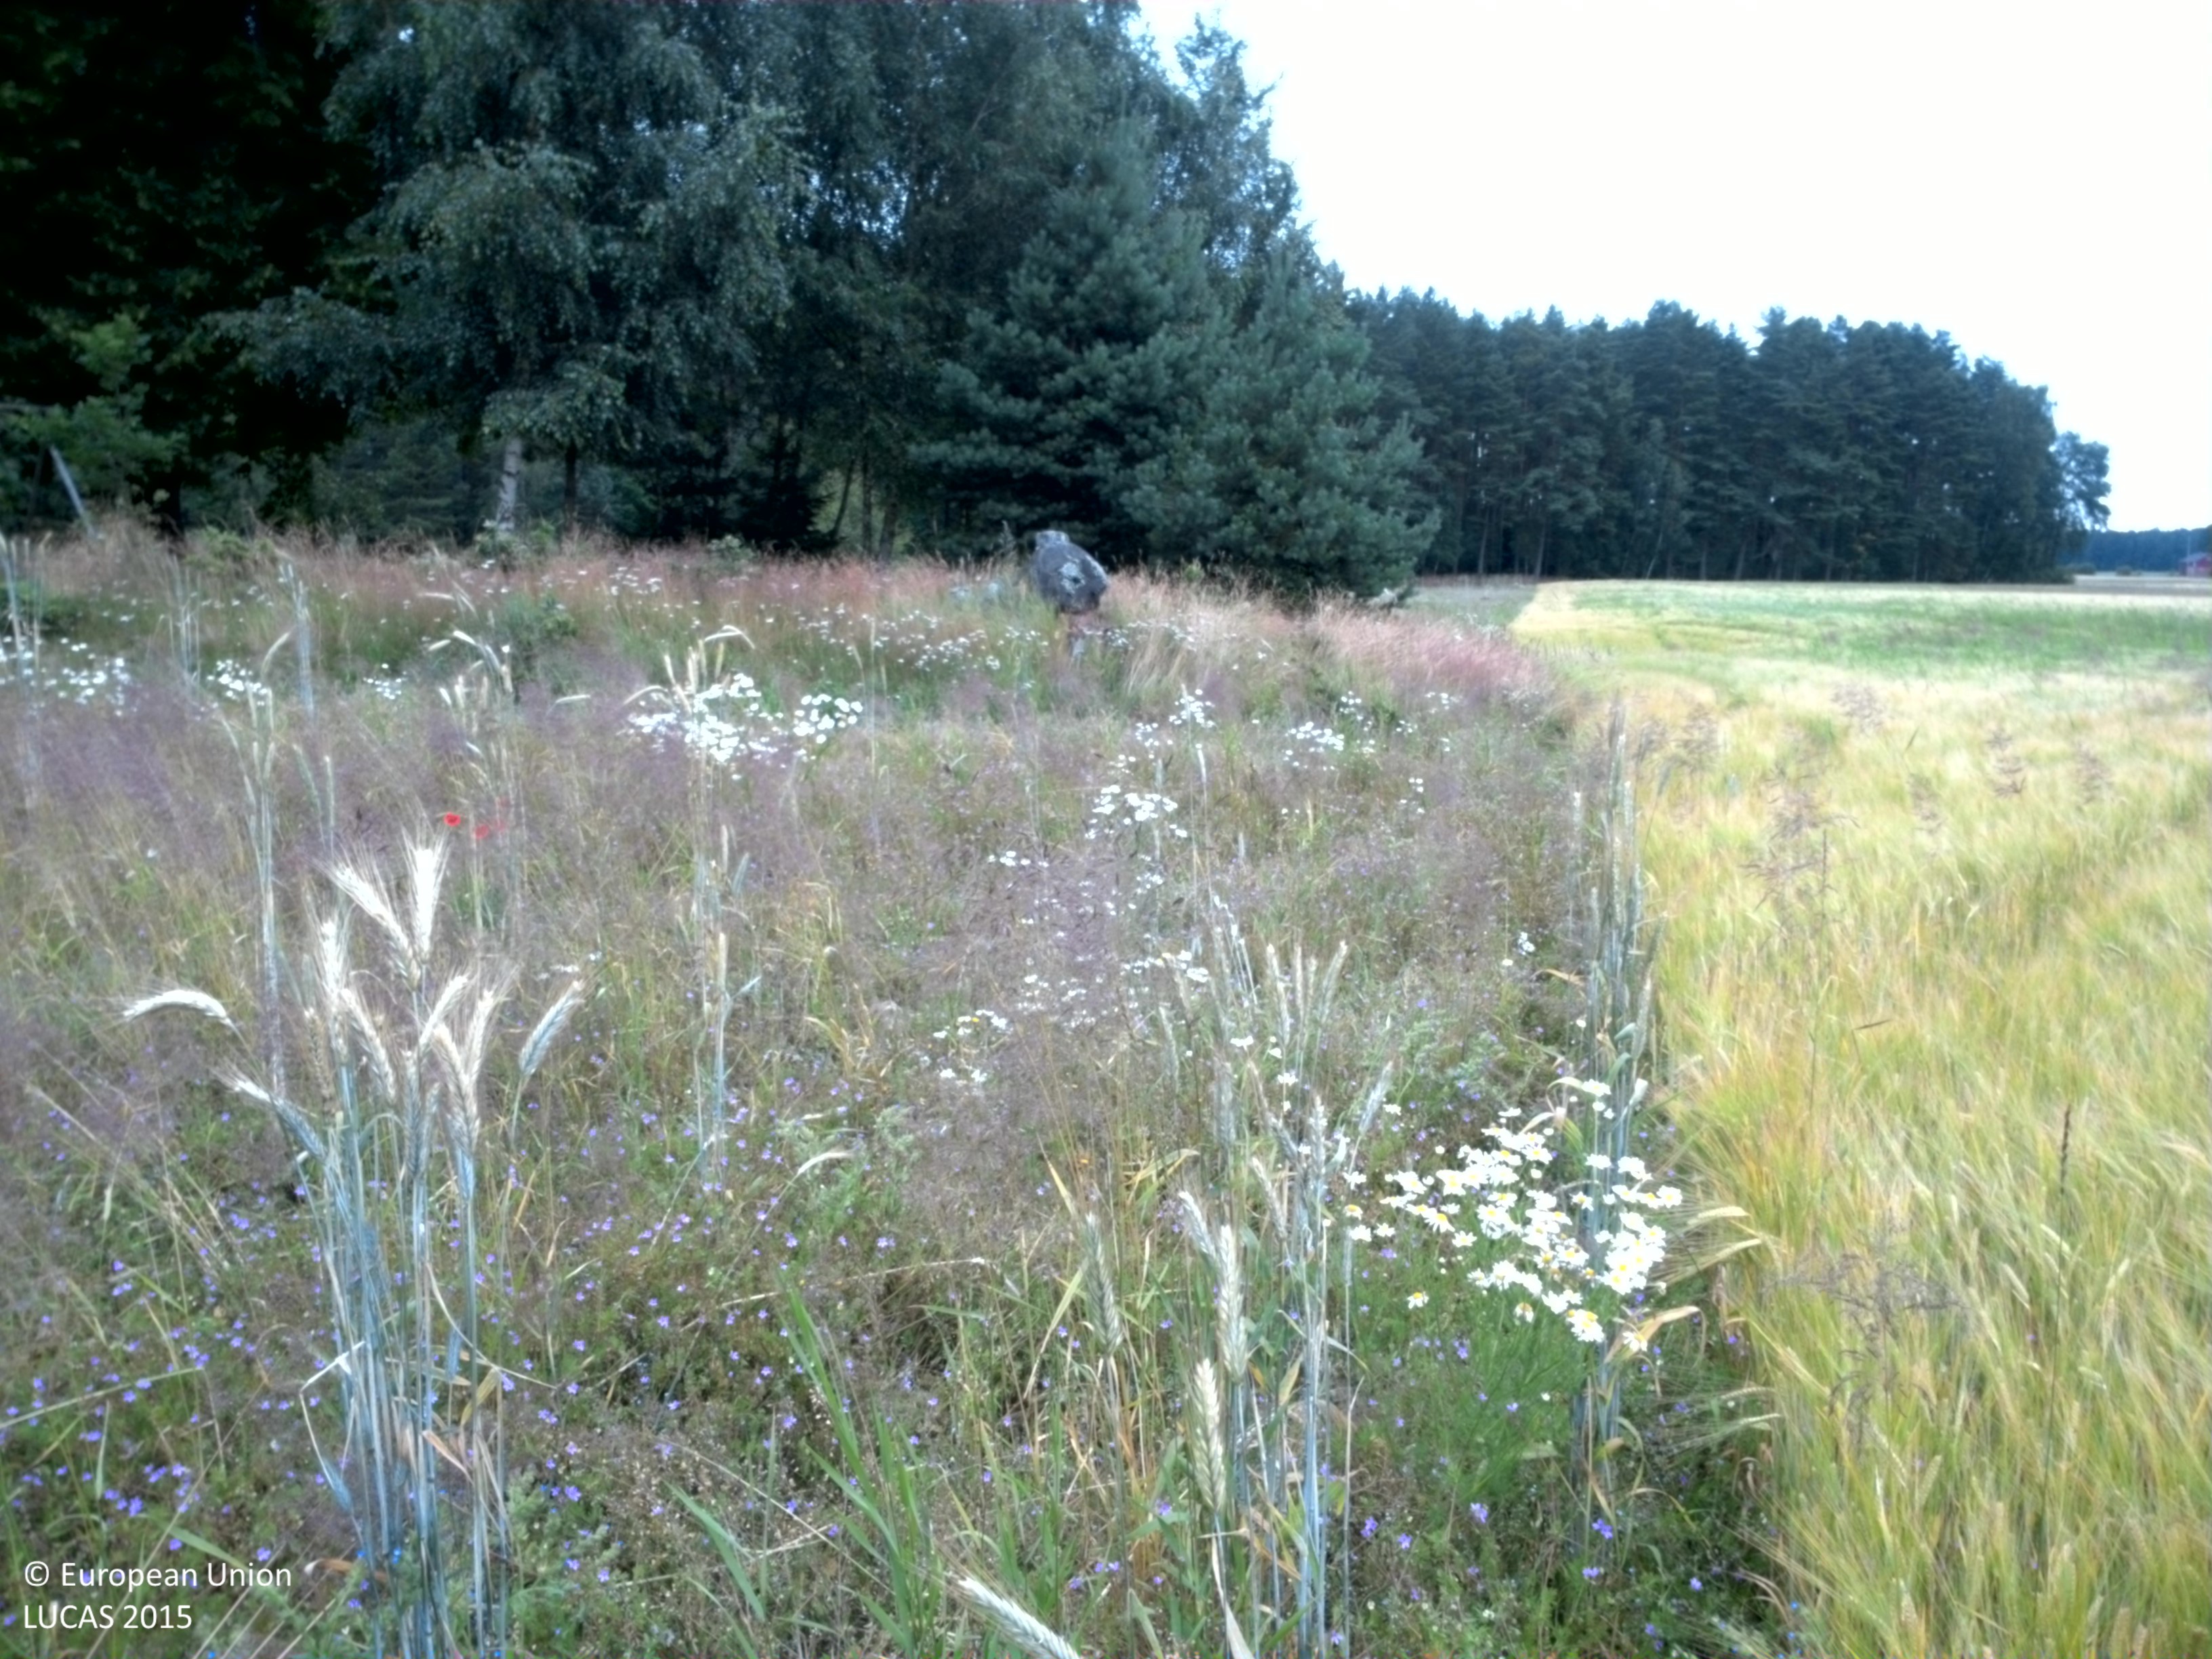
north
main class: Cropland
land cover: Barley
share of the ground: > 75 %
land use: Agriculture (excluding fallow land and kitchen gardens)
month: July
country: SE
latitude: 58.3764
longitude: 13.3285
